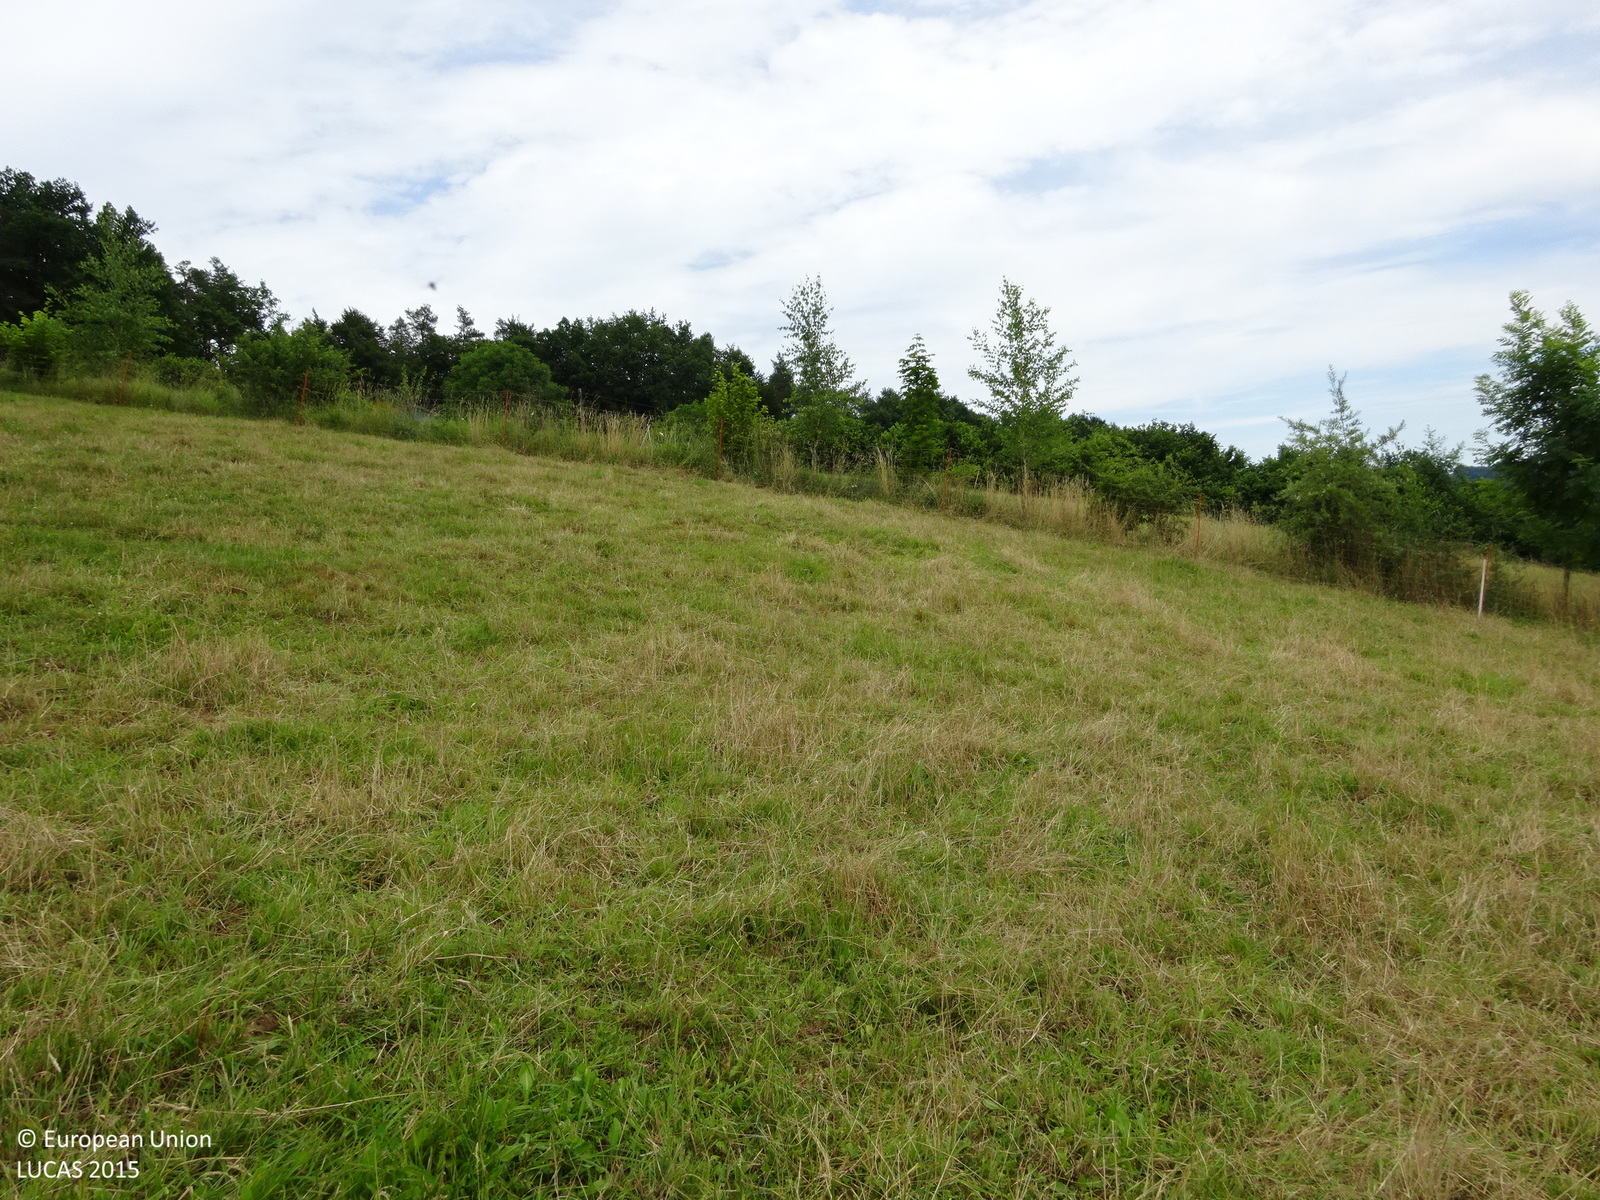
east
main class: Grassland
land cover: Grassland without tree/shrub cover
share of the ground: > 75 %
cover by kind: herbaceous plants 100 %
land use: Agriculture (excluding fallow land and kitchen gardens)
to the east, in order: Grassland without tree/shrub cover; Fences; Grassland without tree/shrub cover; Fences; Grassland without tree/shrub cover; Electric lines; Grassland without tree/shrub cover; Fences; Grassland with sparse tree/shrub cover; Fences; Other fresh vegetables; Fences; Grassland with sparse tree/shrub cover; Artificial constructions in urban areas; Pine dominated mixed woodland
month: June
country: AT
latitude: 46.7034
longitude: 15.3744
